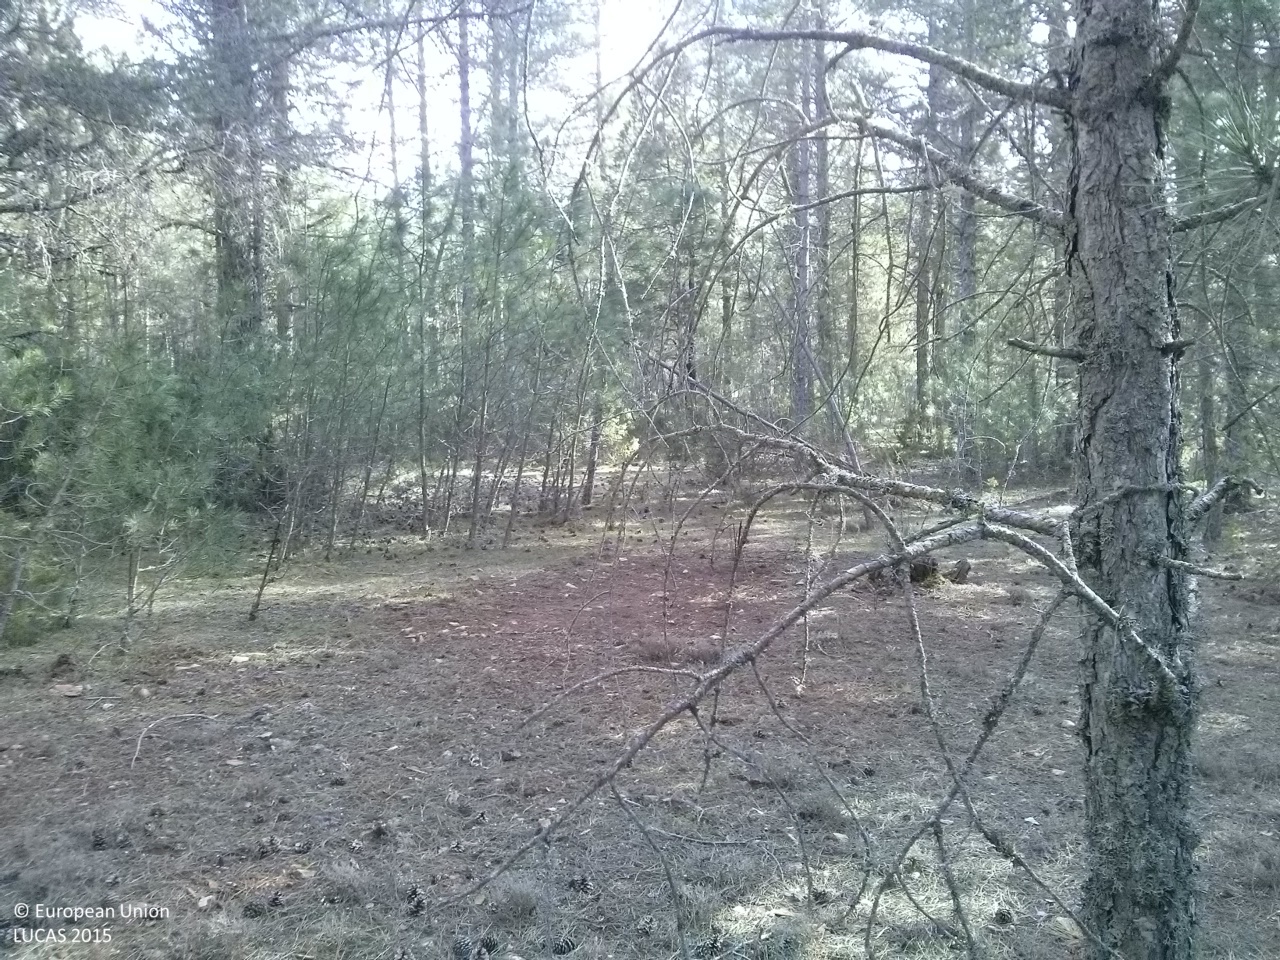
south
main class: Woodland
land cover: Pine dominated coniferous woodland
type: coniferous forest of the mediterranean region
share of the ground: 50 - 75 %
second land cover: Grassland without tree/shrub cover
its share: 10 - 25 %
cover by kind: coniferous forest trees 80 %, herbaceous plants 15 %, shrubs 5 %
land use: Forestry
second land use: Agriculture (excluding fallow land and kitchen gardens)
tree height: > 5 m
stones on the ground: 25 - 50 %
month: April
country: ES
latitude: 40.1247
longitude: -1.9015
